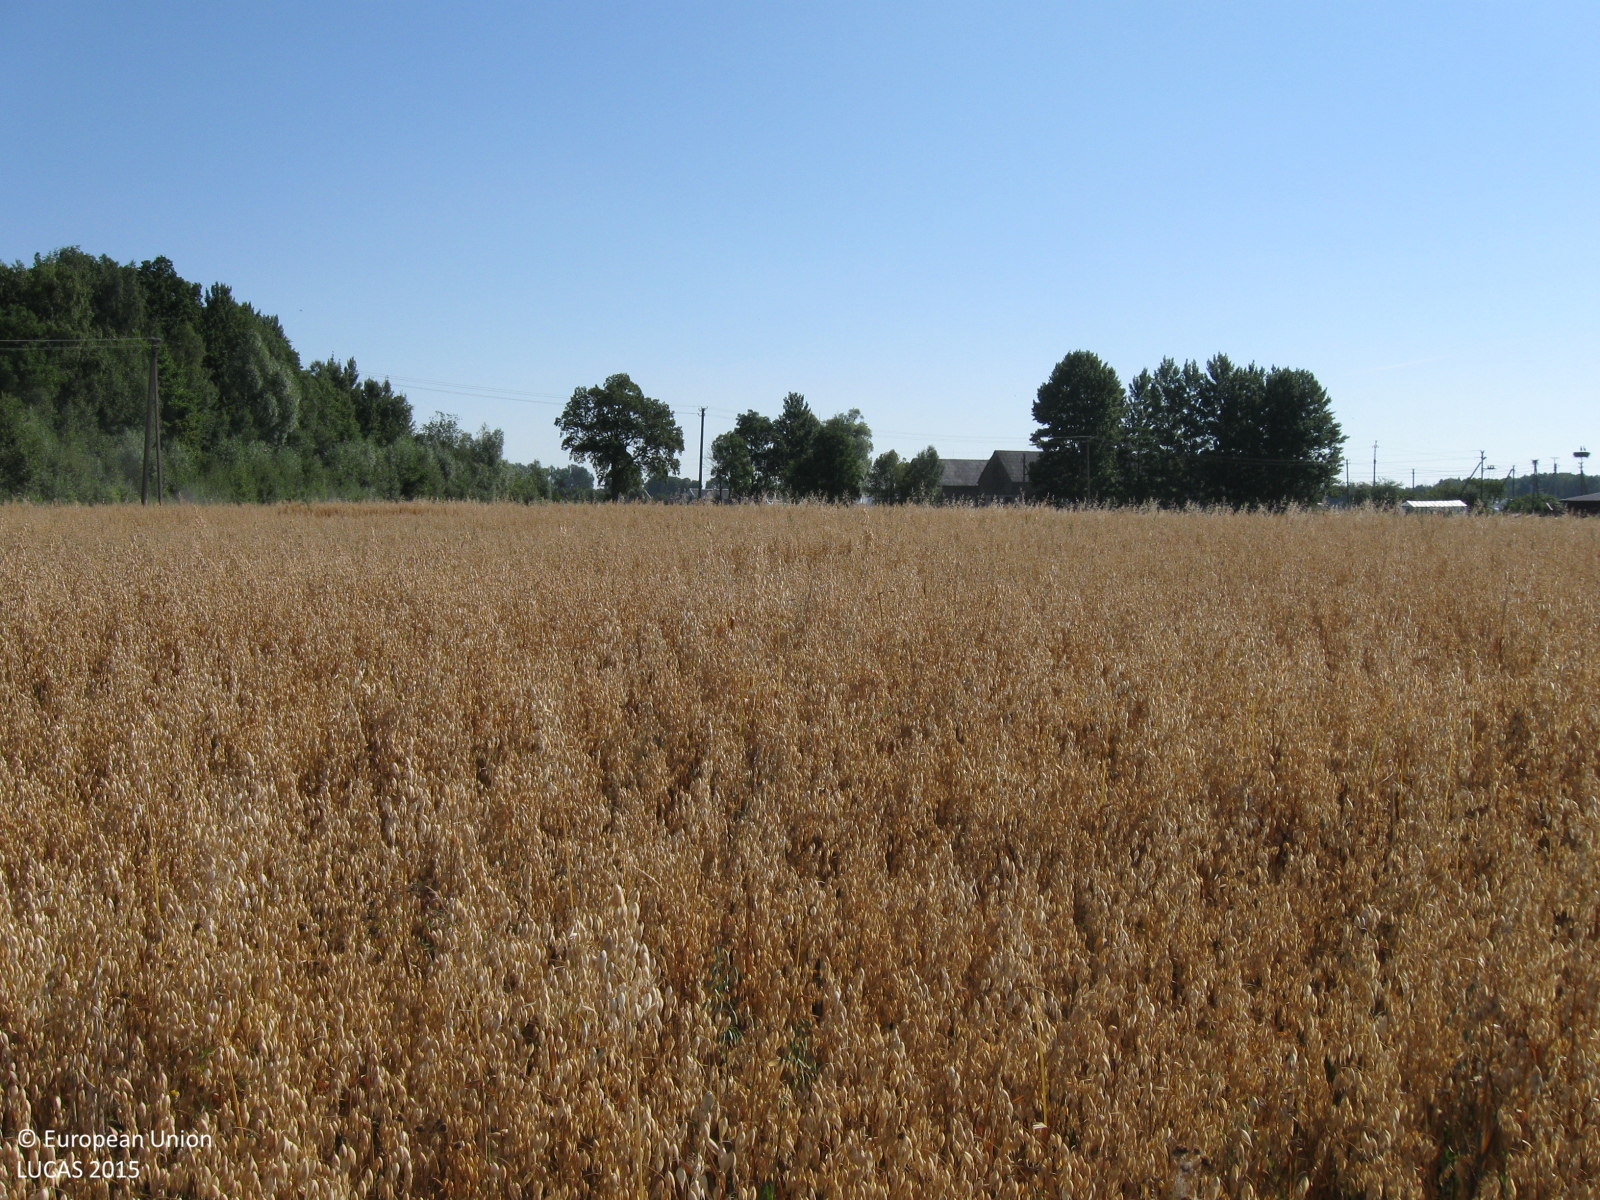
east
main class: Cropland
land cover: Oats
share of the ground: > 75 %
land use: Agriculture (excluding fallow land and kitchen gardens)
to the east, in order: Oats; Potatoes; Electric lines; Potatoes; Other root crops; Grassland without tree/shrub cover; Fences; Grassland without tree/shrub cover; Fences; Electric lines; Grass margins; Paved roads, cycling and walking lanes; Grassland without tree/shrub cover; Electric lines; Grassland without tree/shrub cover
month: August
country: LT
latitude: 55.4104
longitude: 22.4917
